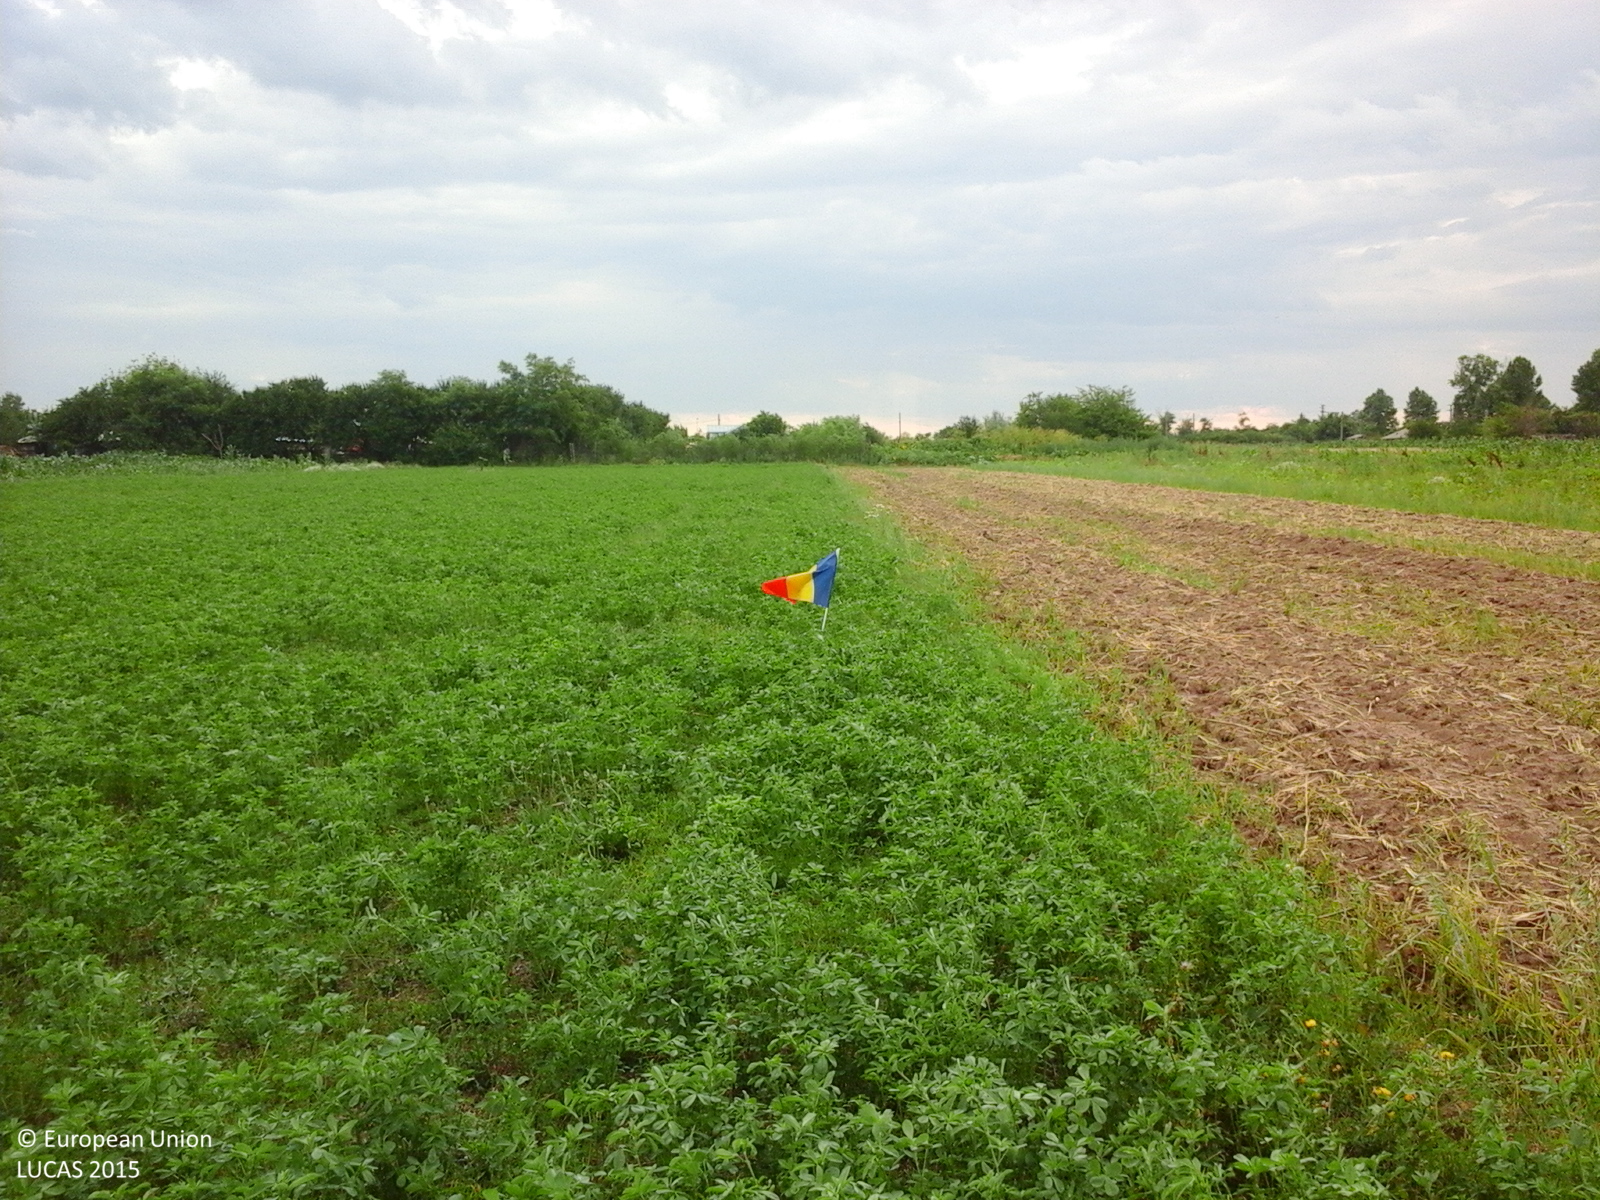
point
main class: Cropland
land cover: Lucerne
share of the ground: > 75 %
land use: Agriculture (excluding fallow land and kitchen gardens)
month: July
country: RO
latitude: 44.2664
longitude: 25.3313
